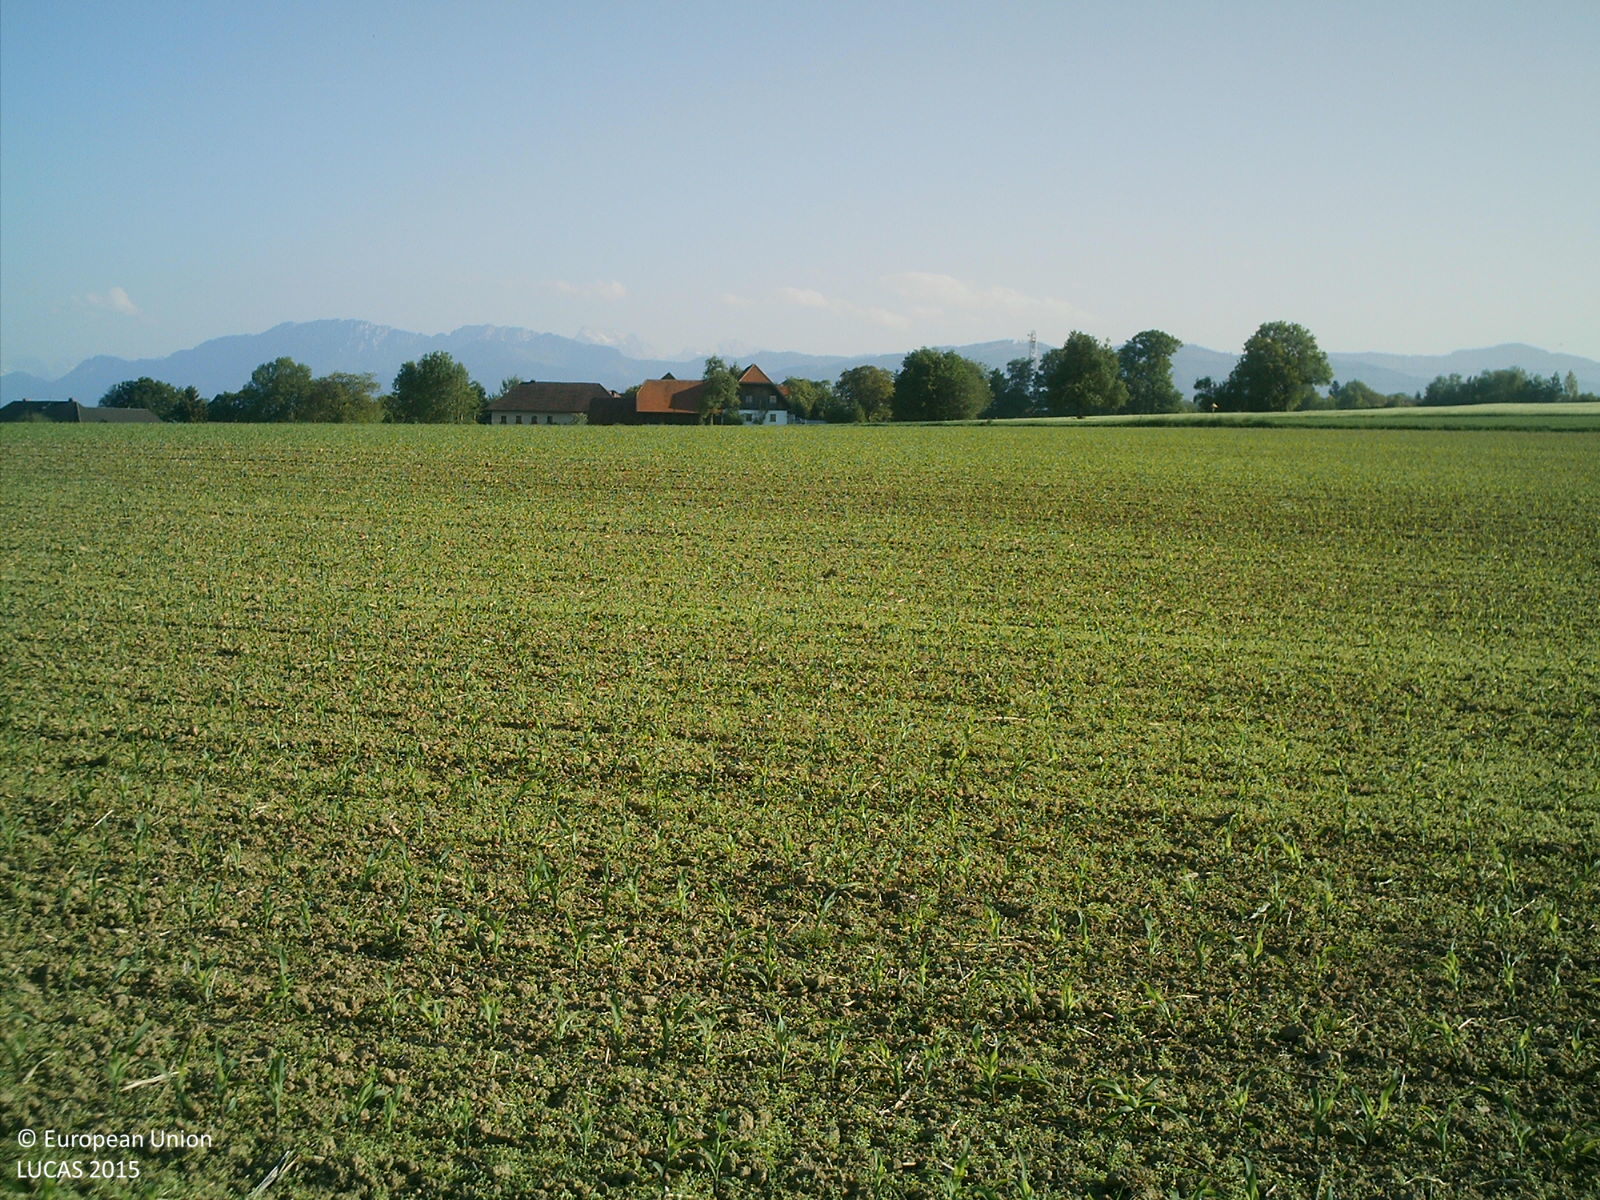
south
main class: Cropland
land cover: Maize
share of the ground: < 10 %
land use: Agriculture (excluding fallow land and kitchen gardens)
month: May
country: AT
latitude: 48.0036
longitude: 14.0876
